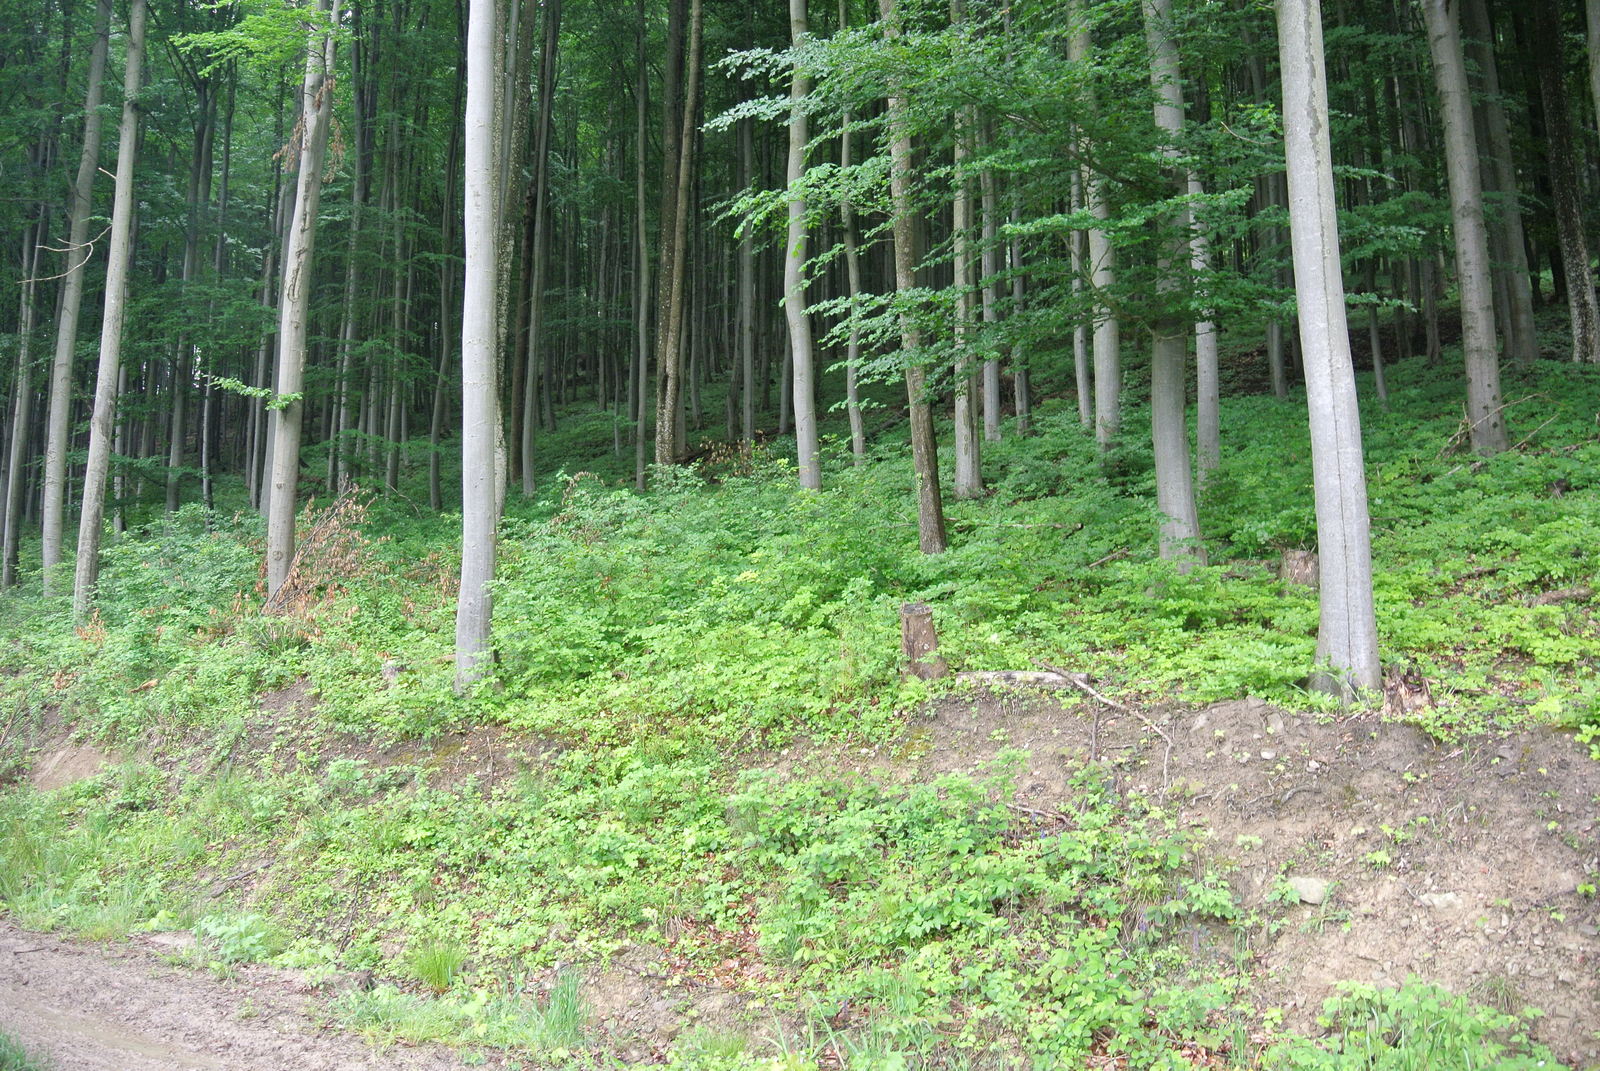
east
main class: Woodland
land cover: Broadleaved woodland
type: mesophytic deciduous forest
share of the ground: > 75 %
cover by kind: broadleaved forest trees 90 %, shrubs 10 %
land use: Forestry
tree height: > 5 m
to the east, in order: Broadleaved woodland; Tracks; Broadleaved woodland
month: May
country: AT
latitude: 48.0852
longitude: 15.8697
